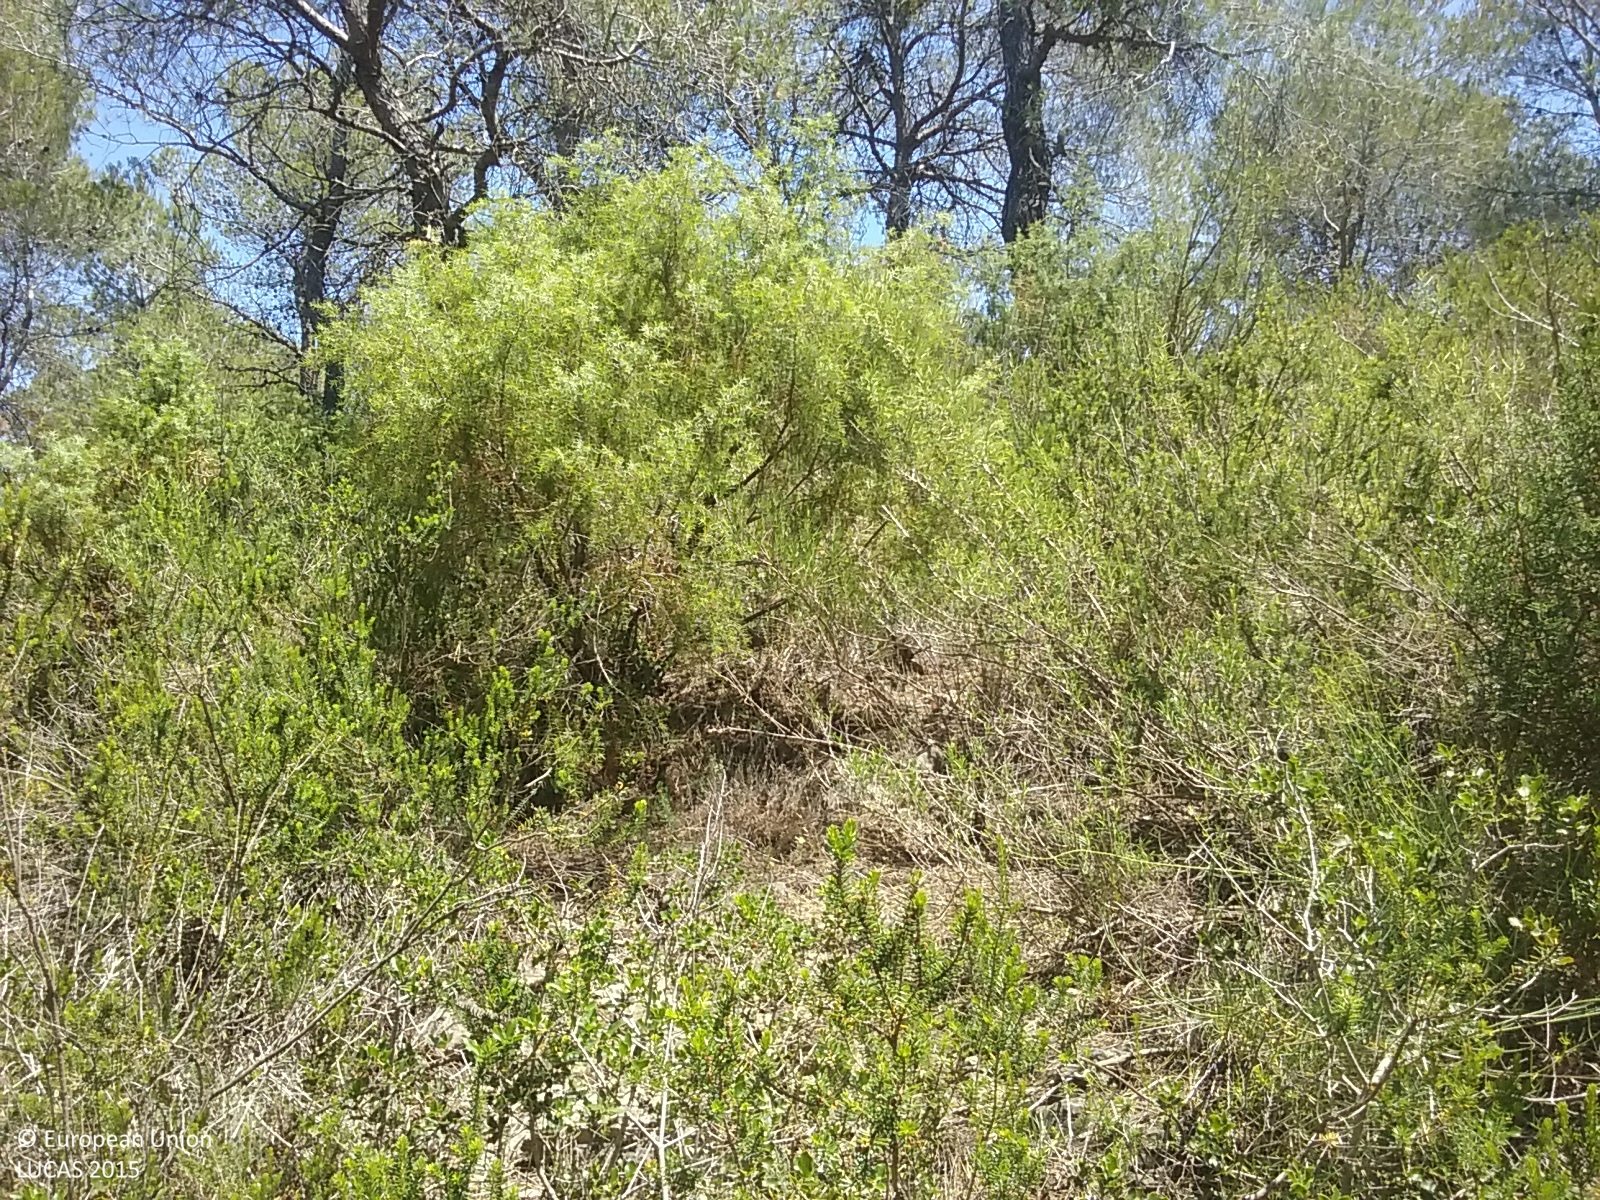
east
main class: Woodland
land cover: Pine dominated coniferous woodland
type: coniferous forest of the mediterranean region
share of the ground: > 75 %
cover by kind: coniferous forest trees 75 %, shrubs 20 %, herbaceous plants 5 %
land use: Semi-natural and natural areas not in use
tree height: > 5 m
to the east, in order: Pine dominated coniferous woodland; Dry stone walls; Pine dominated coniferous woodland; Dry stone walls; Pine dominated coniferous woodland; Dry stone walls; Pine dominated coniferous woodland; Tracks; Pine dominated coniferous woodland; Dry stone walls; Tracks; Pine dominated coniferous woodland; Dry stone walls; Pine dominated coniferous woodland; Dry stone walls; Pine dominated coniferous woodland; Dry stone walls; Pine dominated coniferous woodland; Dry stone walls; Pine dominated coniferous woodland; Dry stone walls; Pine dominated coniferous woodland; Dry stone walls; Pine dominated coniferous woodland; Dry stone walls; Pine dominated coniferous woodland; Dry stone walls; Pine dominated coniferous woodland; Dry stone walls; Pine dominated coniferous woodland; Dry stone walls; Pine dominated coniferous woodland; Tracks; Shrubland with sparse tree cover; Dry stone walls; Shrubland with sparse tree cover; Tracks; Shrubland with sparse tree cover
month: June
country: ES
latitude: 40.9969
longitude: 0.5892
